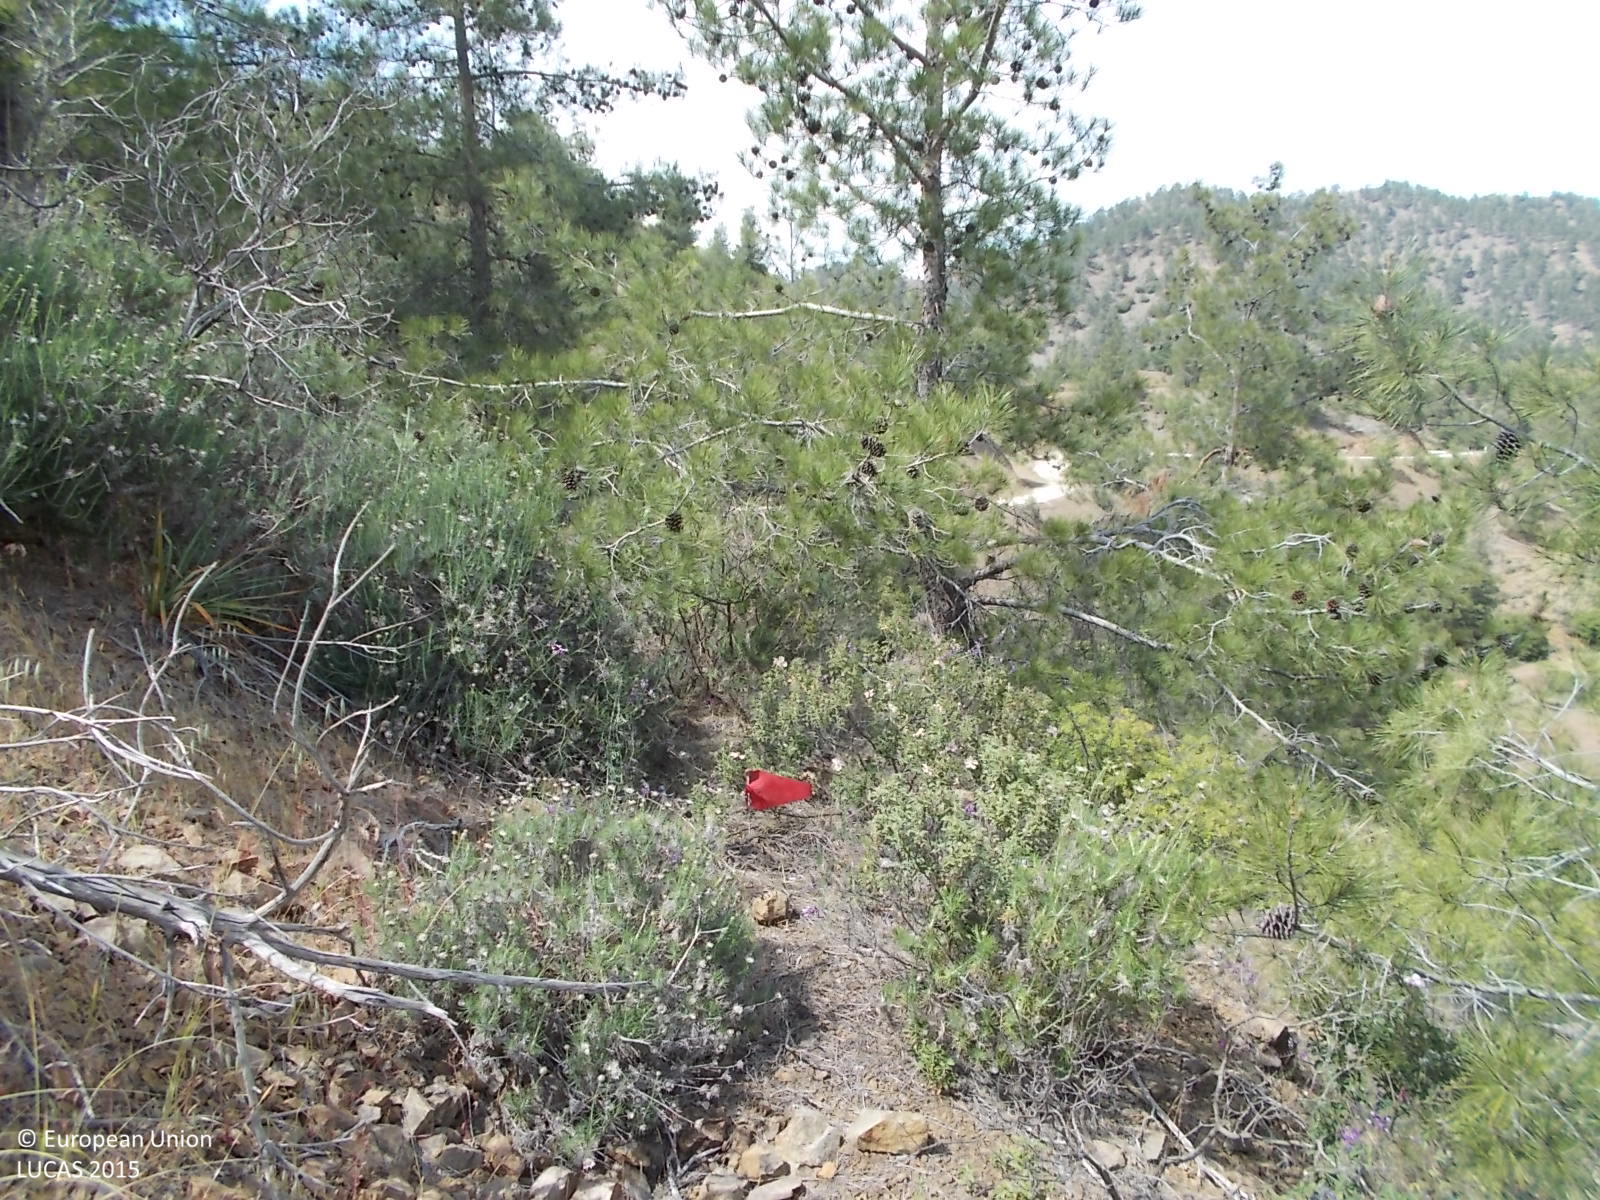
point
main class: Woodland
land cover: Pine dominated coniferous woodland
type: coniferous forest of the mediterranean region
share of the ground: > 75 %
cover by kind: coniferous forest trees 100 %
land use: Forestry
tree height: > 5 m
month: May
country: CY
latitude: 34.9622
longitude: 33.0756
